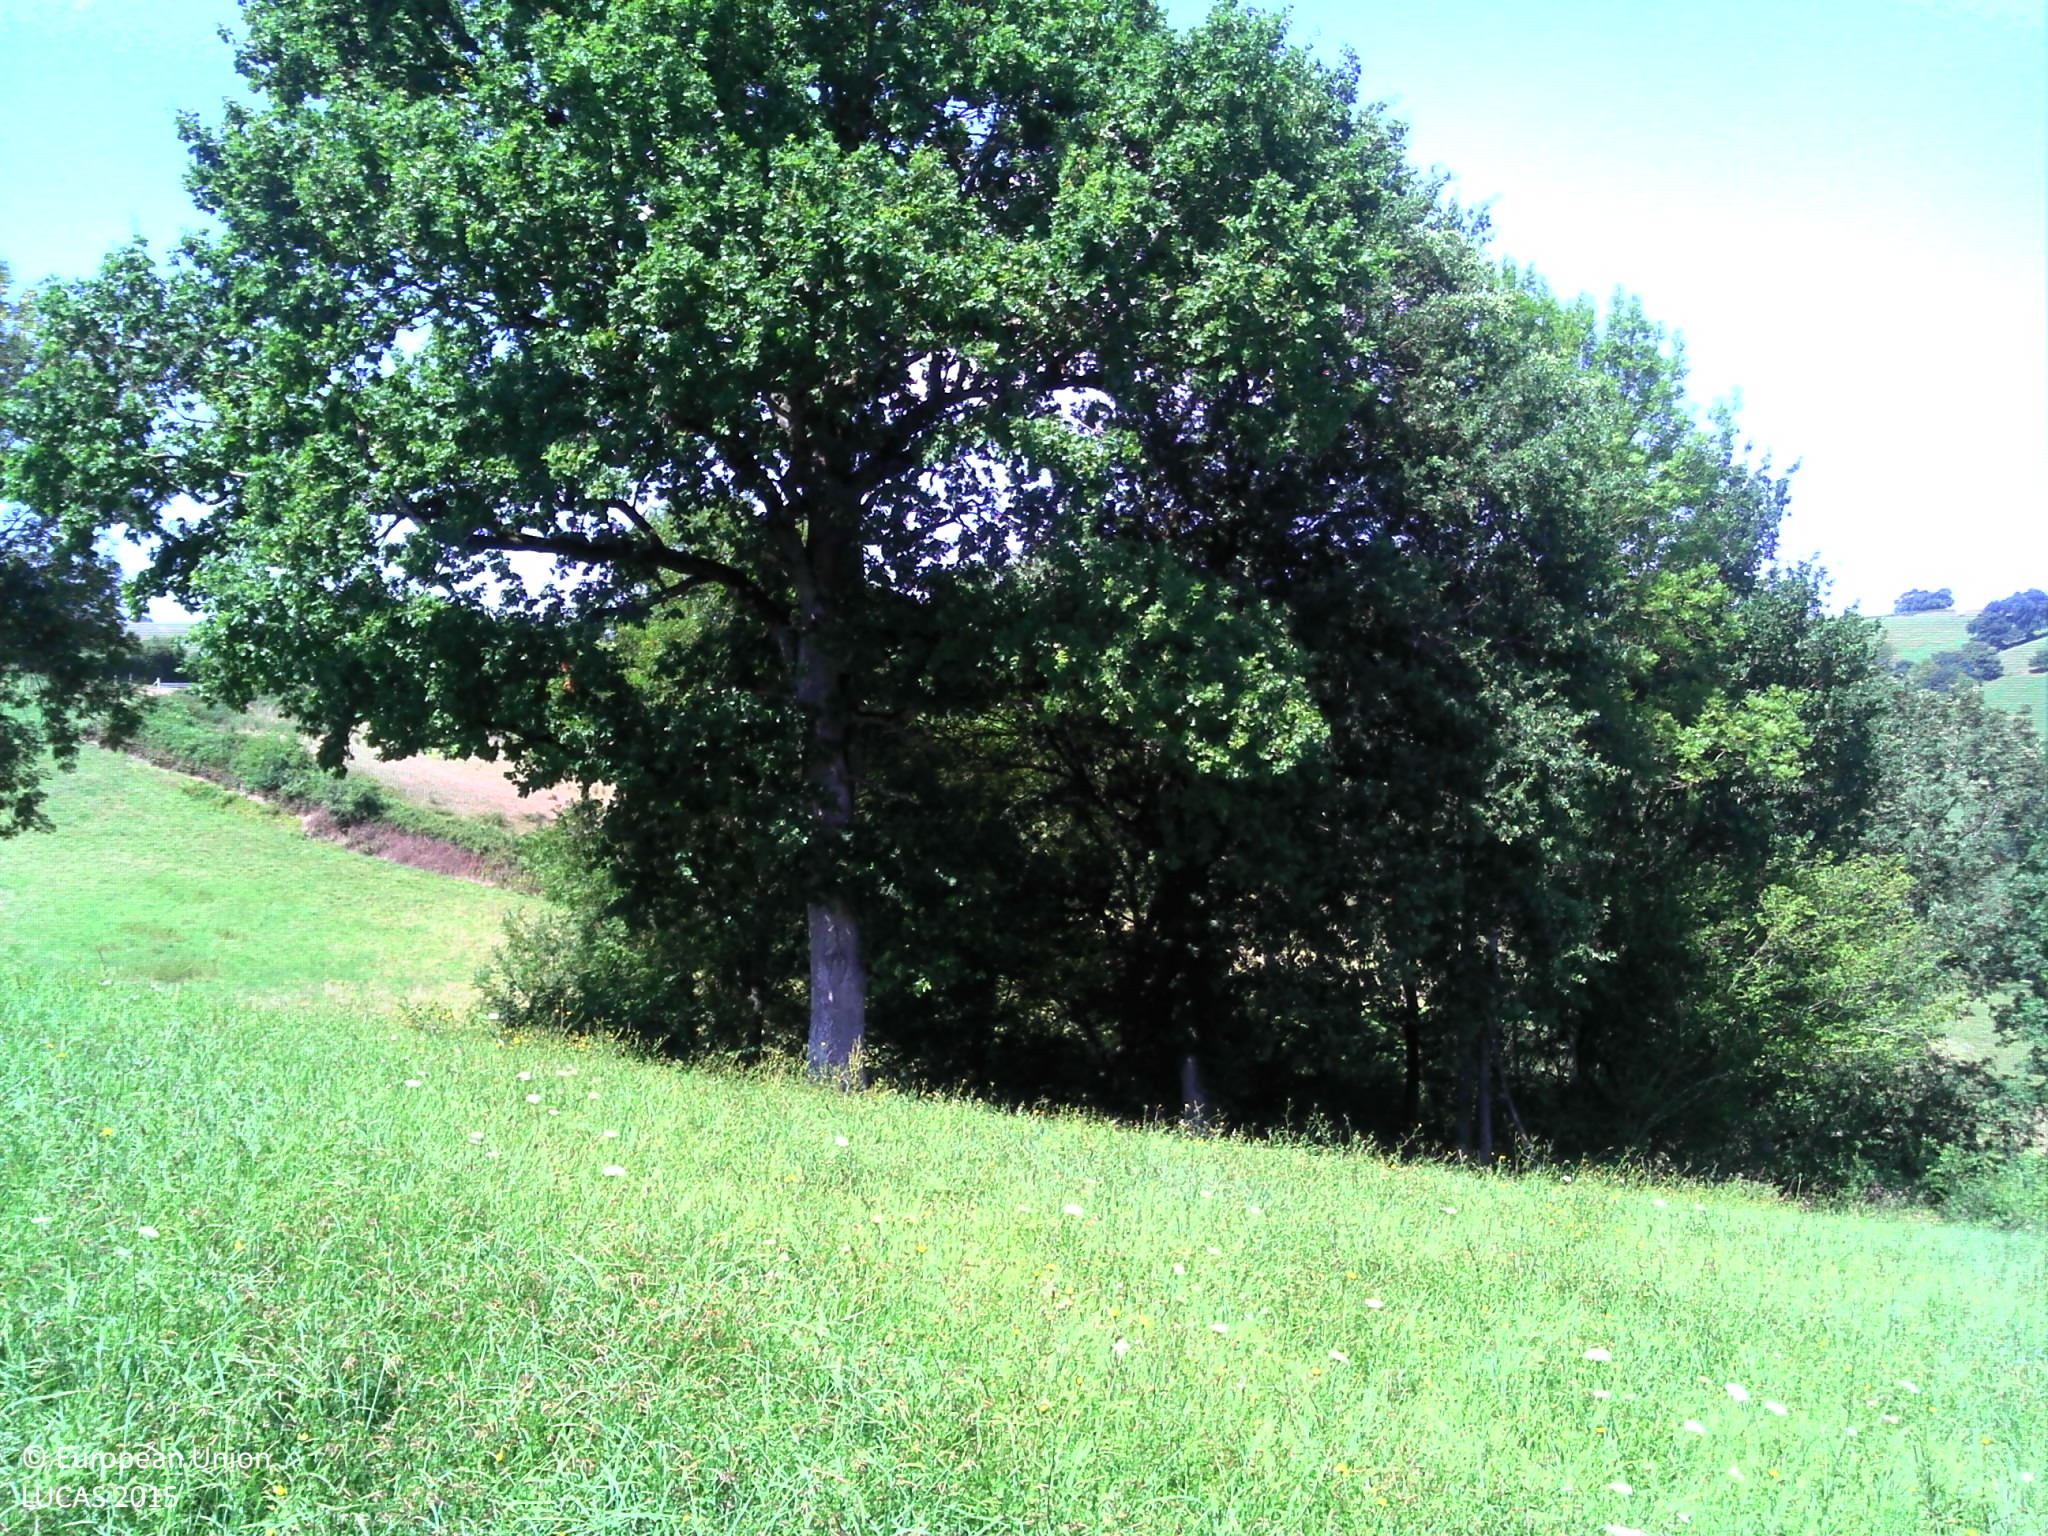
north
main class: Cropland
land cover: Temporary grasslands
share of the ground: > 75 %
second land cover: Lucerne
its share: 10 - 25 %
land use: Agriculture (excluding fallow land and kitchen gardens)
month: August
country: FR
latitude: 43.3167
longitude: -1.0981
